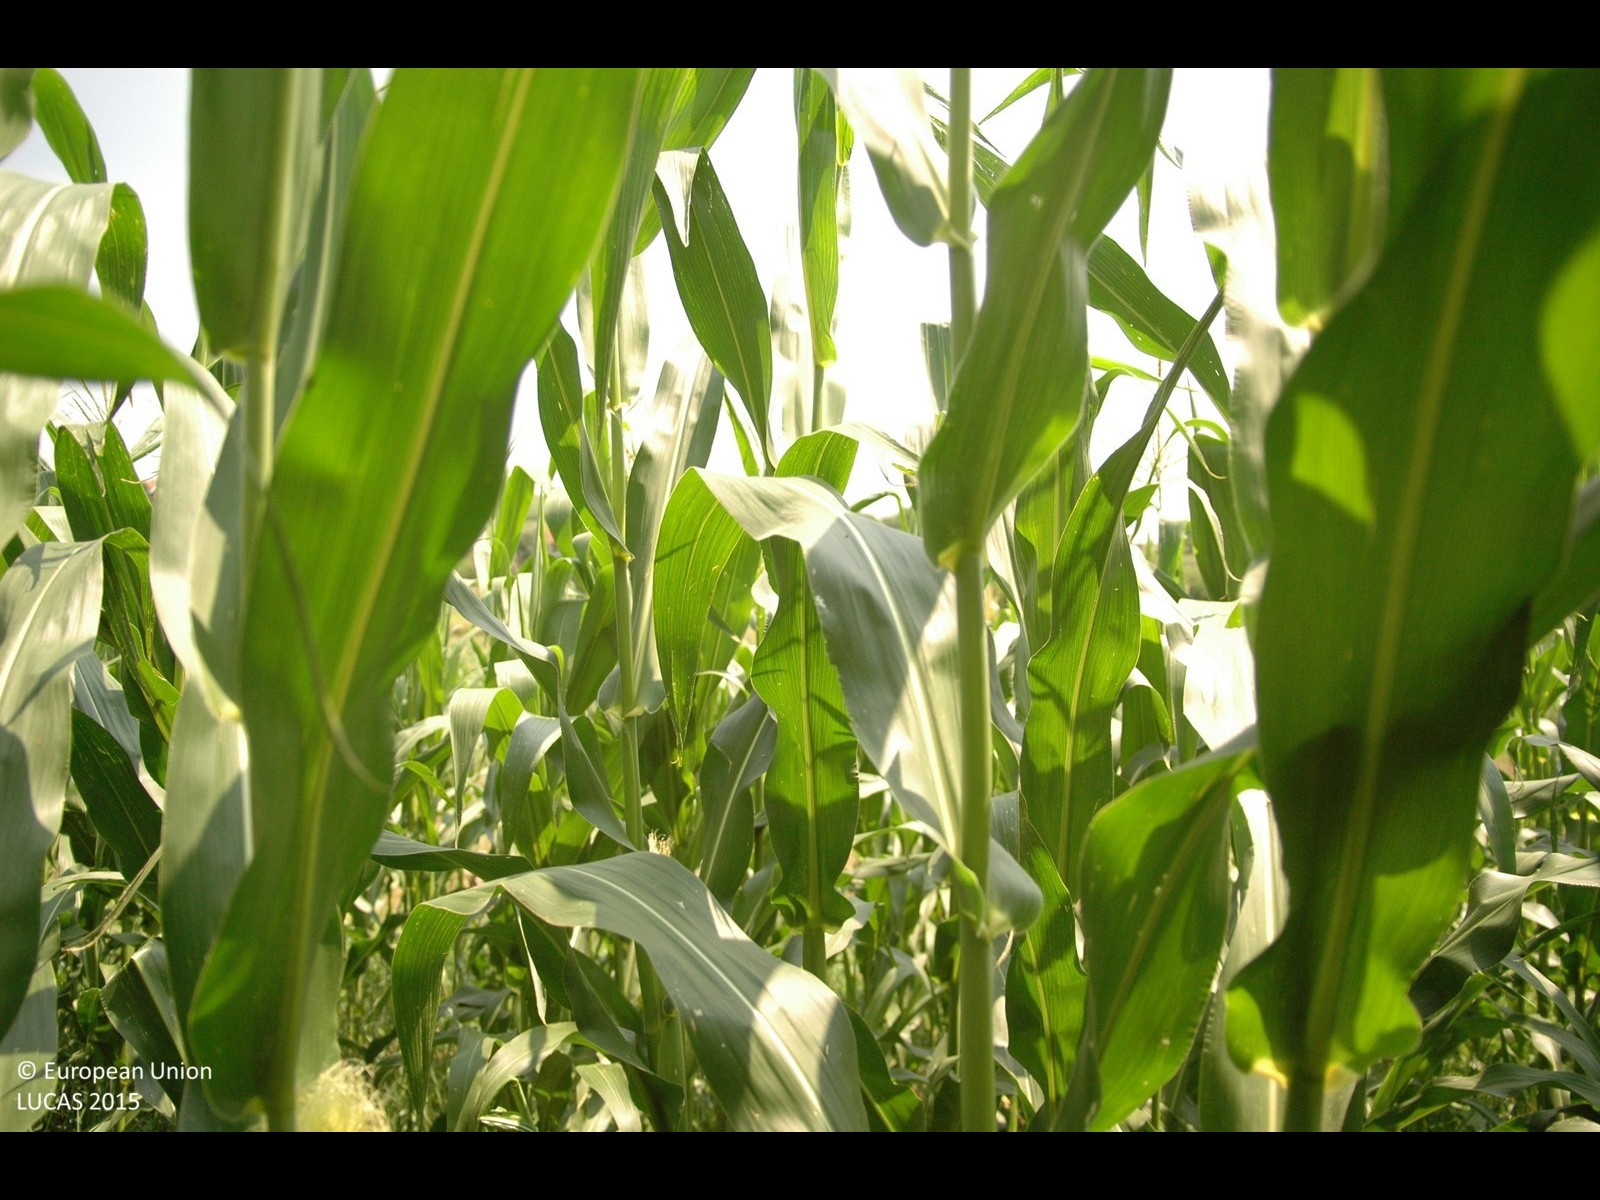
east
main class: Cropland
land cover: Maize
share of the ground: > 75 %
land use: Agriculture (excluding fallow land and kitchen gardens)
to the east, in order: Maize; Spontaneously vegetated surfaces; Maize; Grassland without tree/shrub cover; Tracks; Spontaneously vegetated surfaces; Grassland without tree/shrub cover; Abandoned hedges; Rivers and streams; Abandoned hedges; Grassland without tree/shrub cover; Maize; Grassland without tree/shrub cover
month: July
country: HR
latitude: 46.1412
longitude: 16.0963
